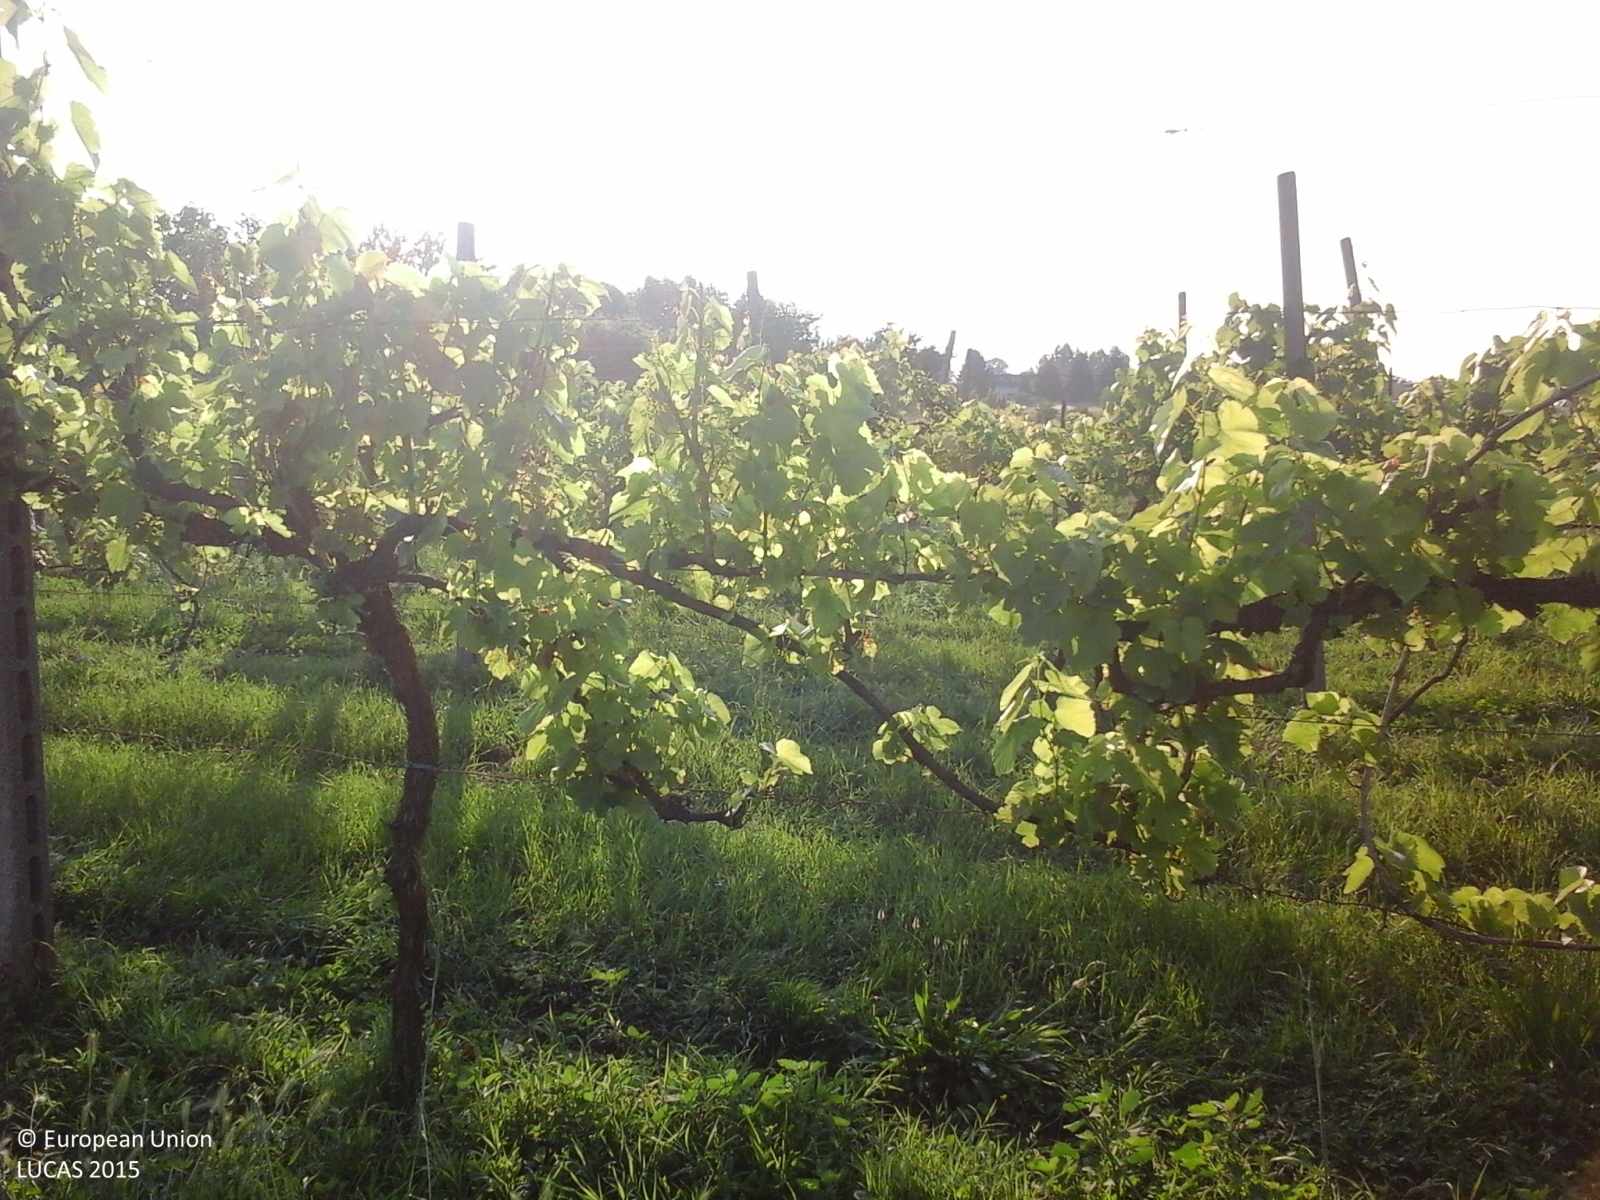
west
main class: Cropland
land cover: Vineyards
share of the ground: 25 - 50 %
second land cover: Grassland without tree/shrub cover
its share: > 75 %
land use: Agriculture (excluding fallow land and kitchen gardens)
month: May
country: IT
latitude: 45.2124
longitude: 10.8770
